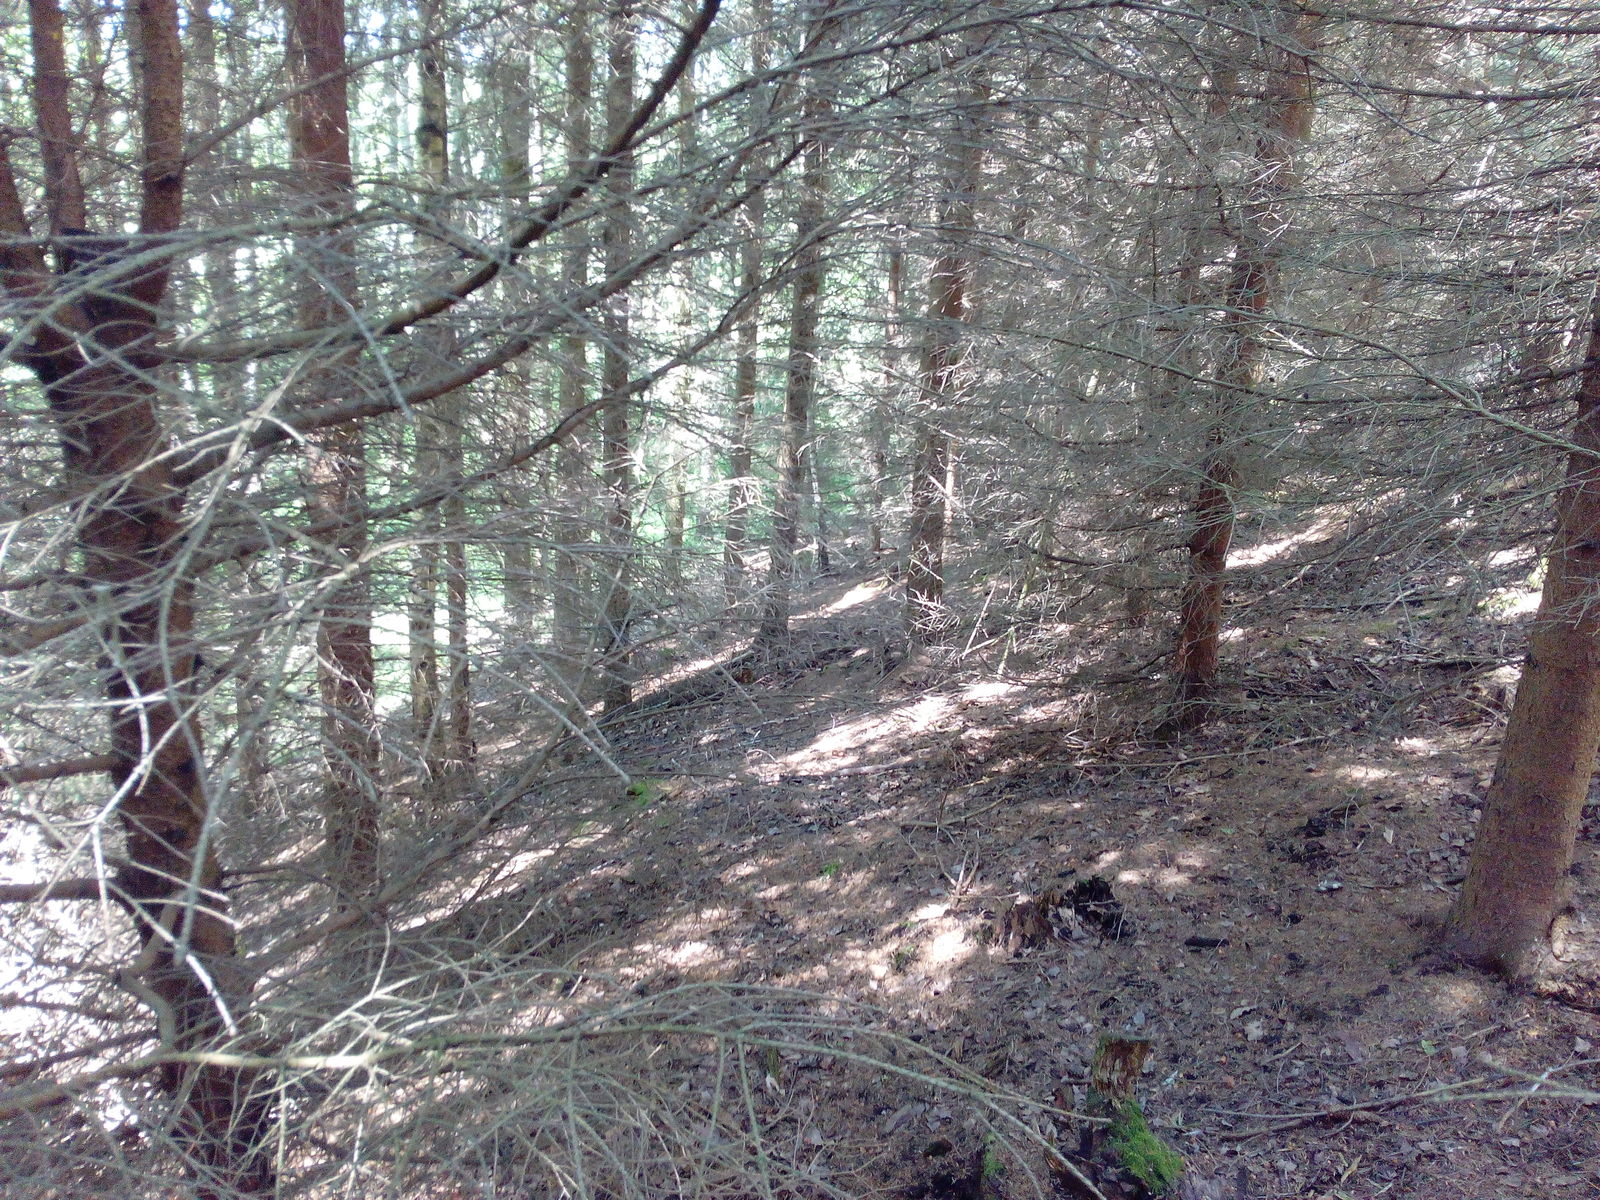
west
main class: Woodland
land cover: Spruce dominated coniferous woodland
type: hemiboreal forest and nemoral coniferous forest and mixed broadleaved-coniferous forest
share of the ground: > 75 %
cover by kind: coniferous forest trees 100 %
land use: Forestry
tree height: > 5 m
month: June
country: DE
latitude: 50.7018
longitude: 10.9484
